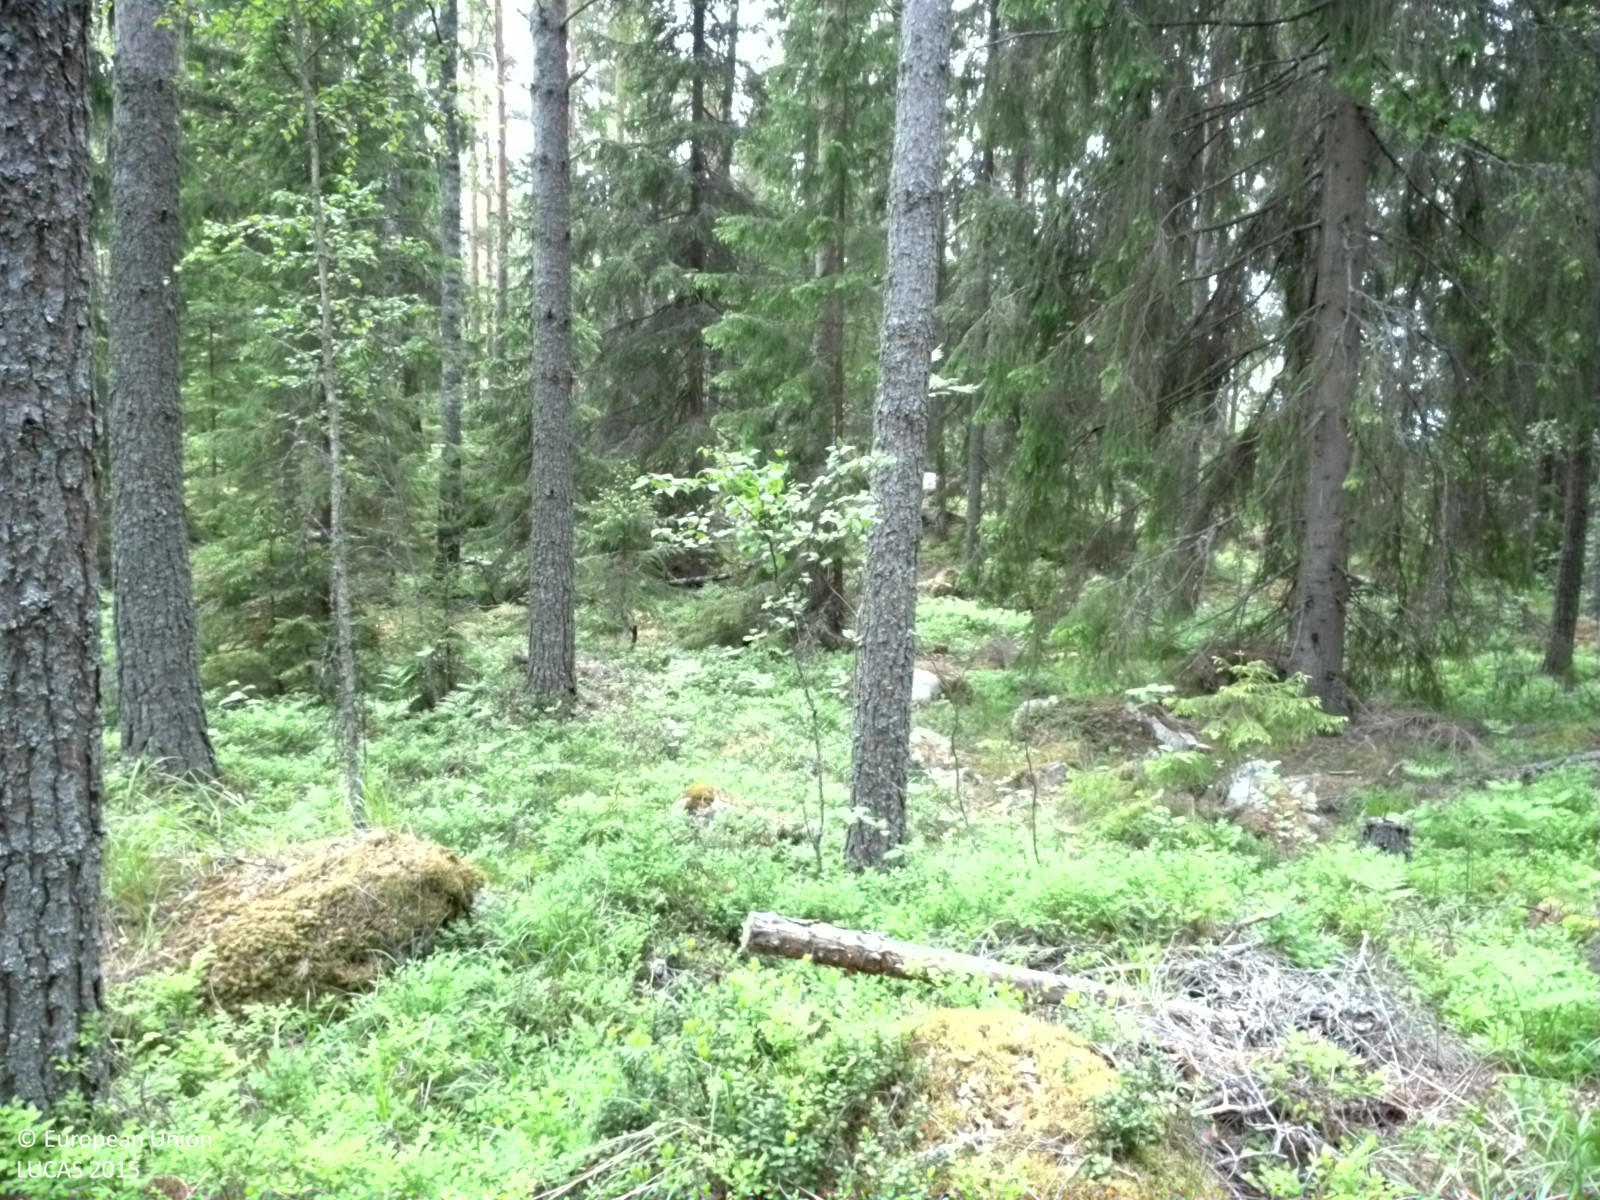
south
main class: Woodland
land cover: Other coniferous woodland
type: boreal forest
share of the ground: 50 - 75 %
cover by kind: coniferous forest trees 50 %, broadleaved forest trees 15 %, shrubs 15 %, herbaceous plants 5 %, lichens and mosses 5 %, consolidated bare surface 5 %
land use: Forestry
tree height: > 5 m
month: June
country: SE
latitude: 60.3287
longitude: 17.0715
